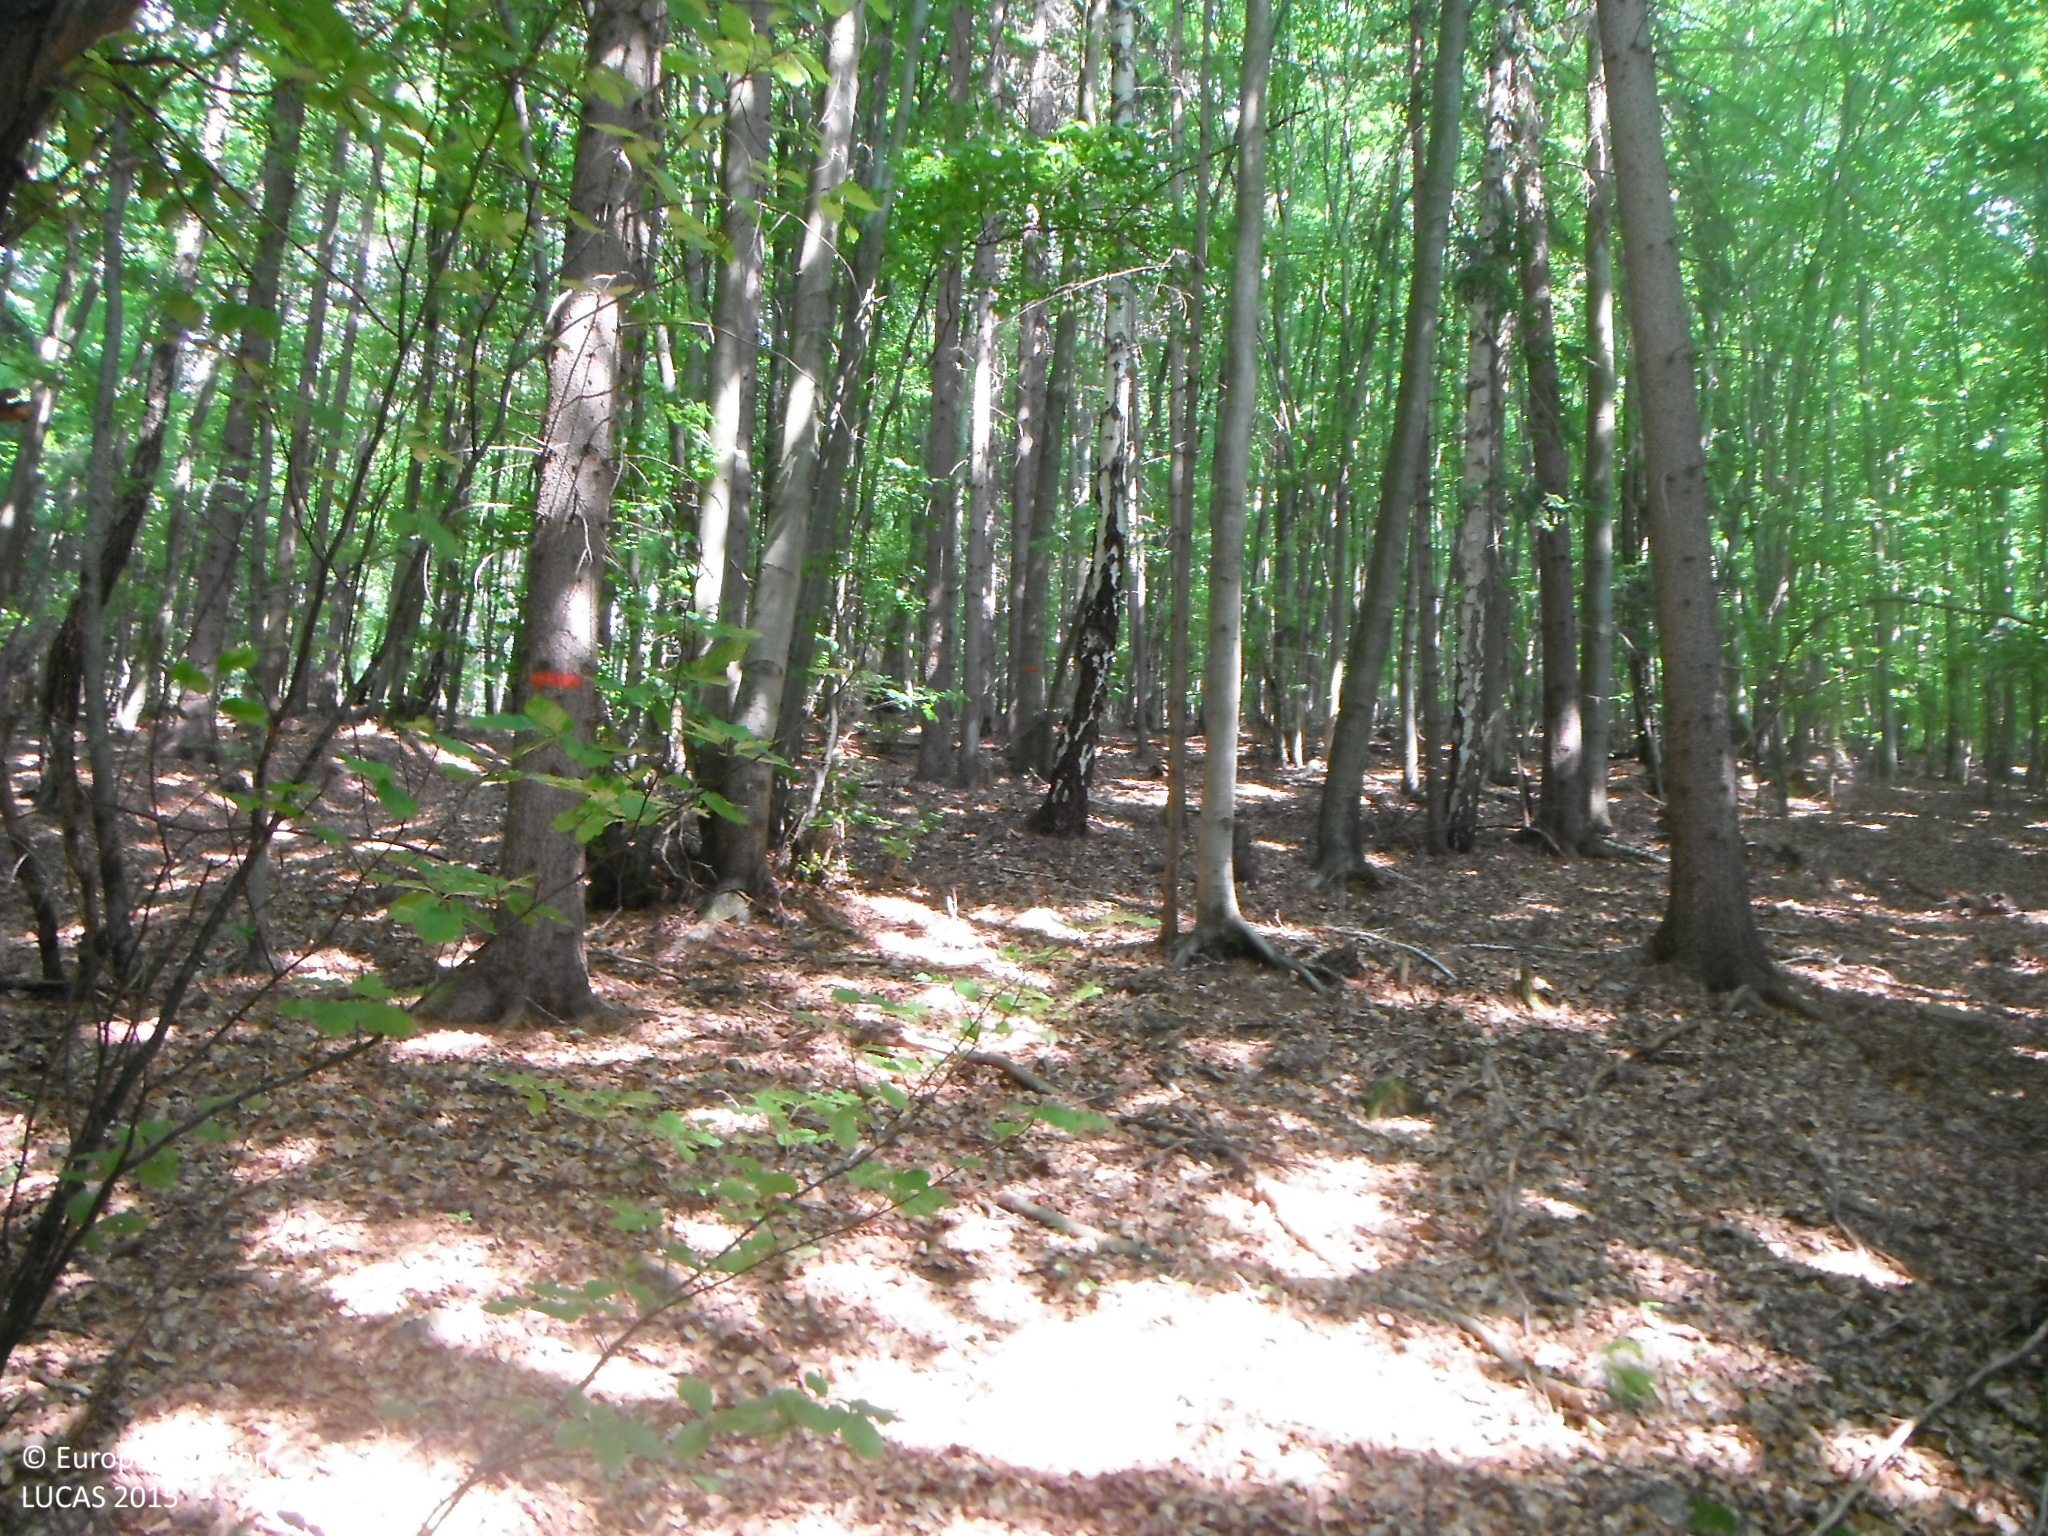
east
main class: Woodland
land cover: Spruce dominated mixed woodland
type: mountainous beech forest
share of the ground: > 75 %
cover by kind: broadleaved forest trees 70 %, coniferous forest trees 30 %
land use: Forestry
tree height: > 5 m
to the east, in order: Spruce dominated mixed woodland
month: June
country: SK
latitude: 48.6808
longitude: 19.3001
